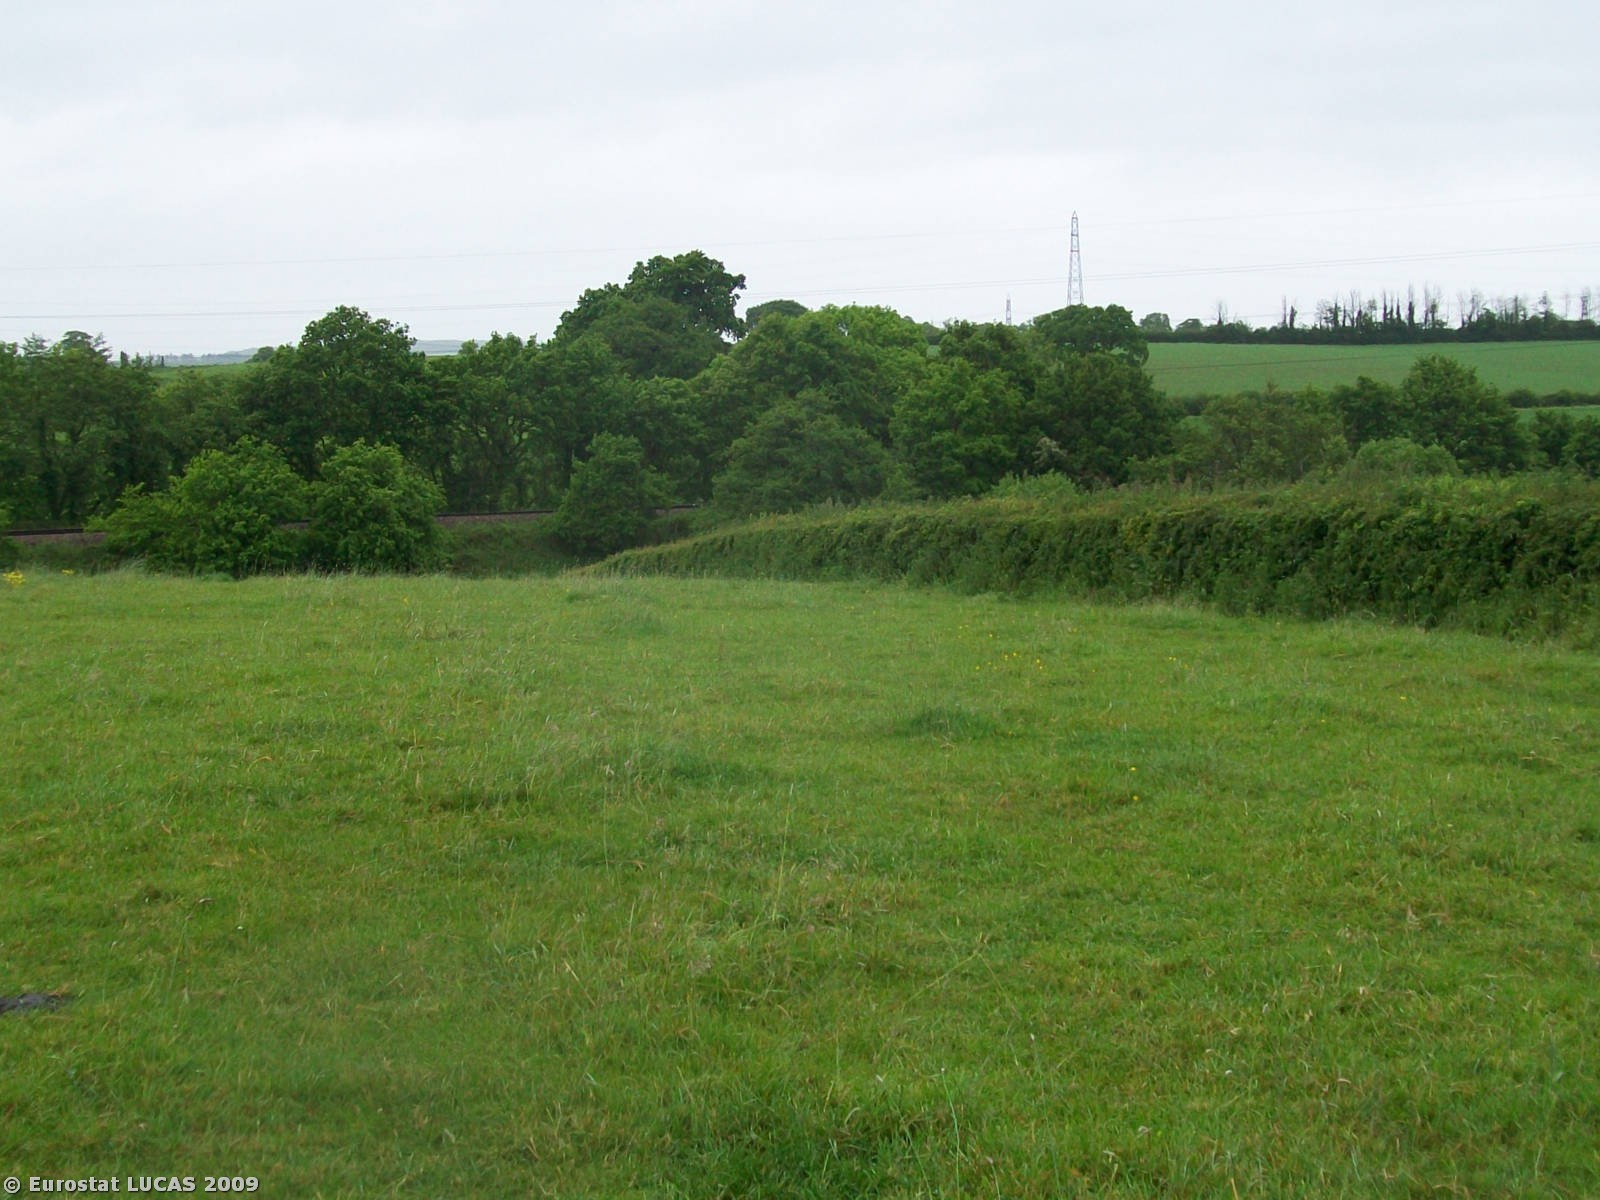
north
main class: Grassland
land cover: Grassland without tree/shrub cover
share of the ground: > 75 %
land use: Agriculture (excluding fallow land and kitchen gardens)
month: May
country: GB
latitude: 50.7570
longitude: -3.3928
